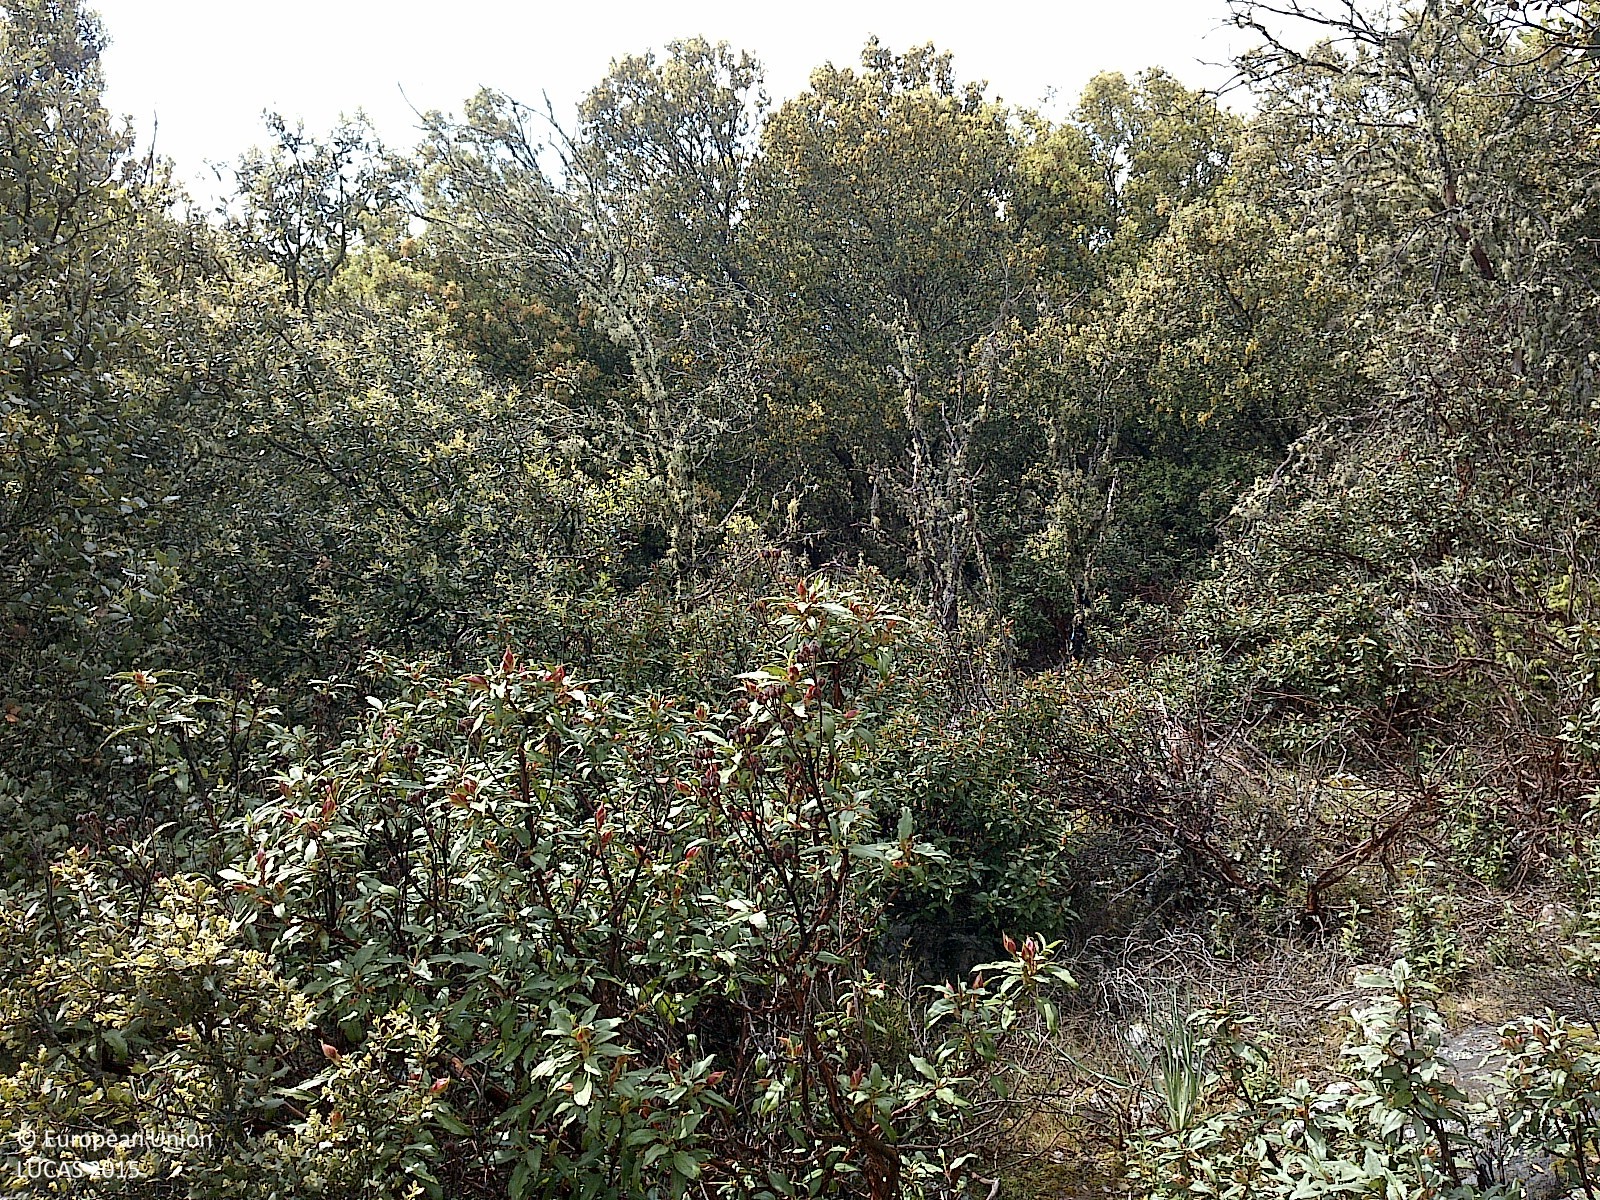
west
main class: Woodland
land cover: Broadleaved woodland
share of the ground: > 75 %
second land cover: Shrubland without tree cover
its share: 50 - 75 %
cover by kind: broadleaved forest trees 75 %, shrubs 15 %, herbaceous plants 5 %, consolidated bare surface 5 %
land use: Forestry
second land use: Agriculture (excluding fallow land and kitchen gardens)
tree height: < 5 m
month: May
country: ES
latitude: 41.8156
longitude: -2.2548
